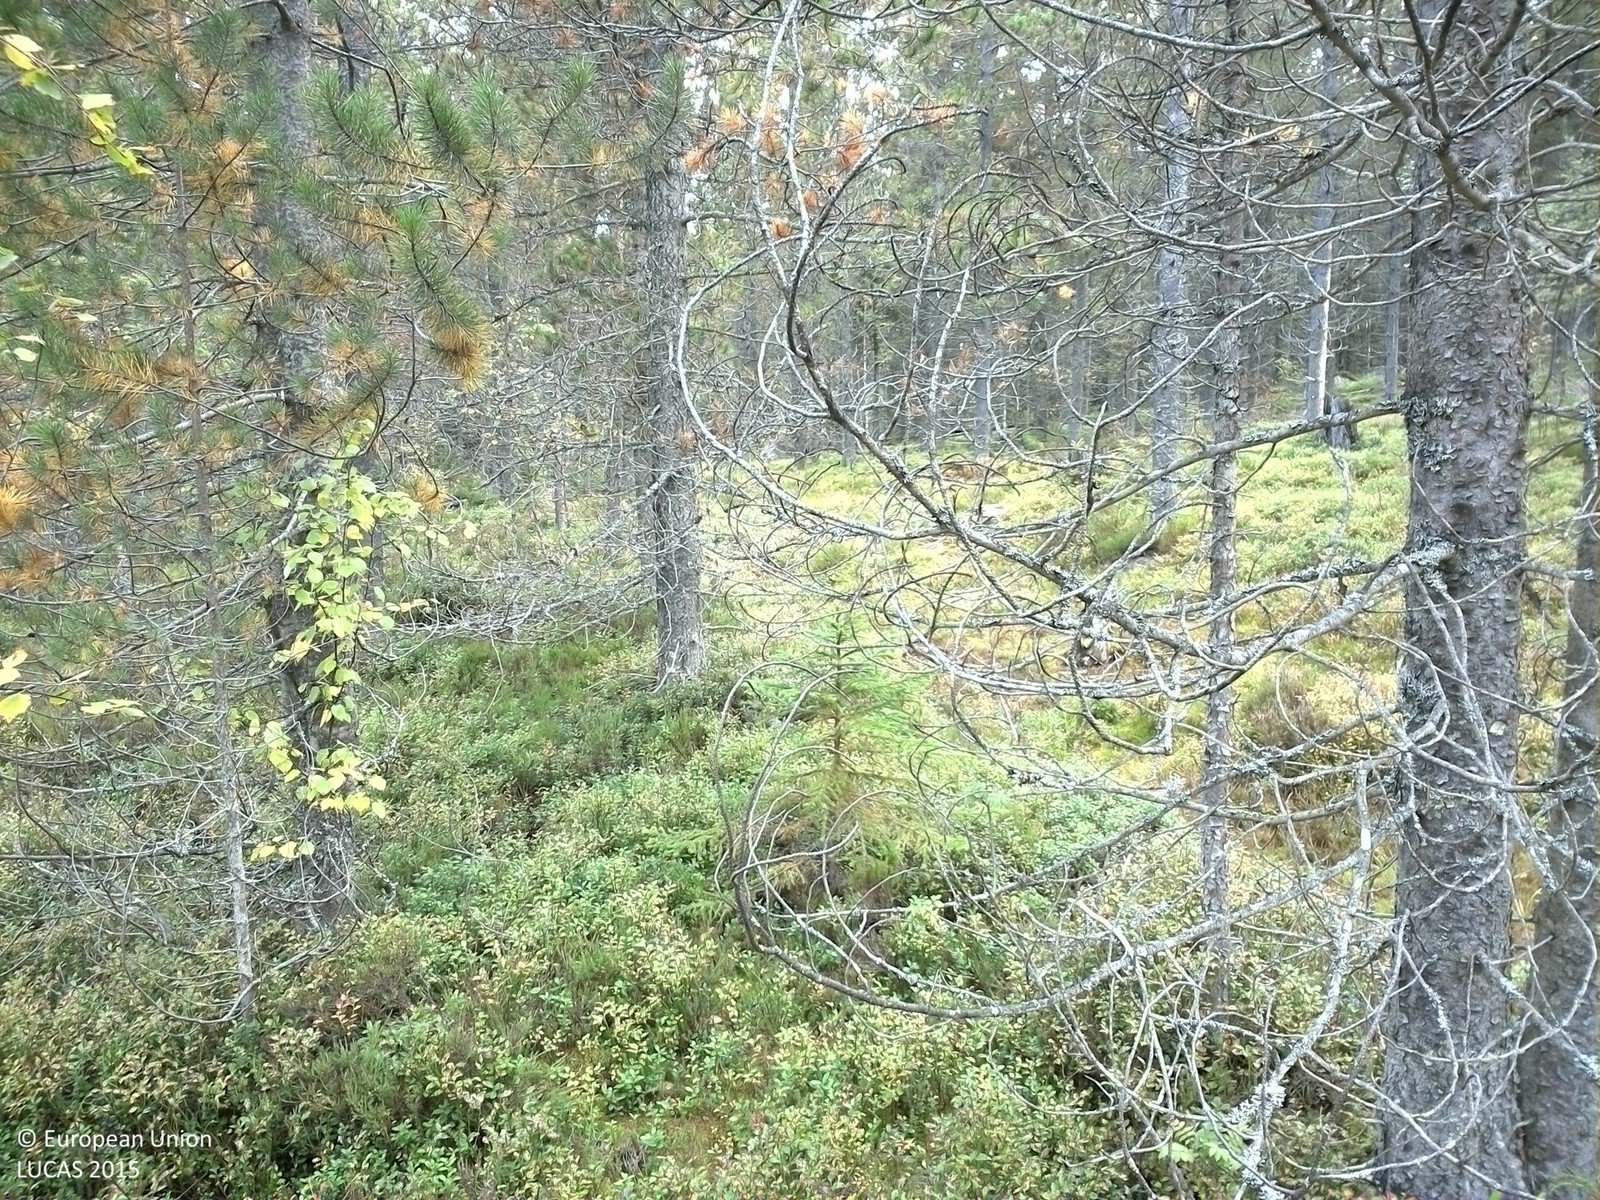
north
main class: Woodland
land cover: Pine dominated mixed woodland
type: exotic forest
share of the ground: 50 - 75 %
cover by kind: coniferous forest trees 50 %, broadleaved forest trees 20 %, shrubs 20 %, lichens and mosses 10 %
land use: Forestry
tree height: > 5 m
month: September
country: SE
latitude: 61.3609
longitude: 15.3524
